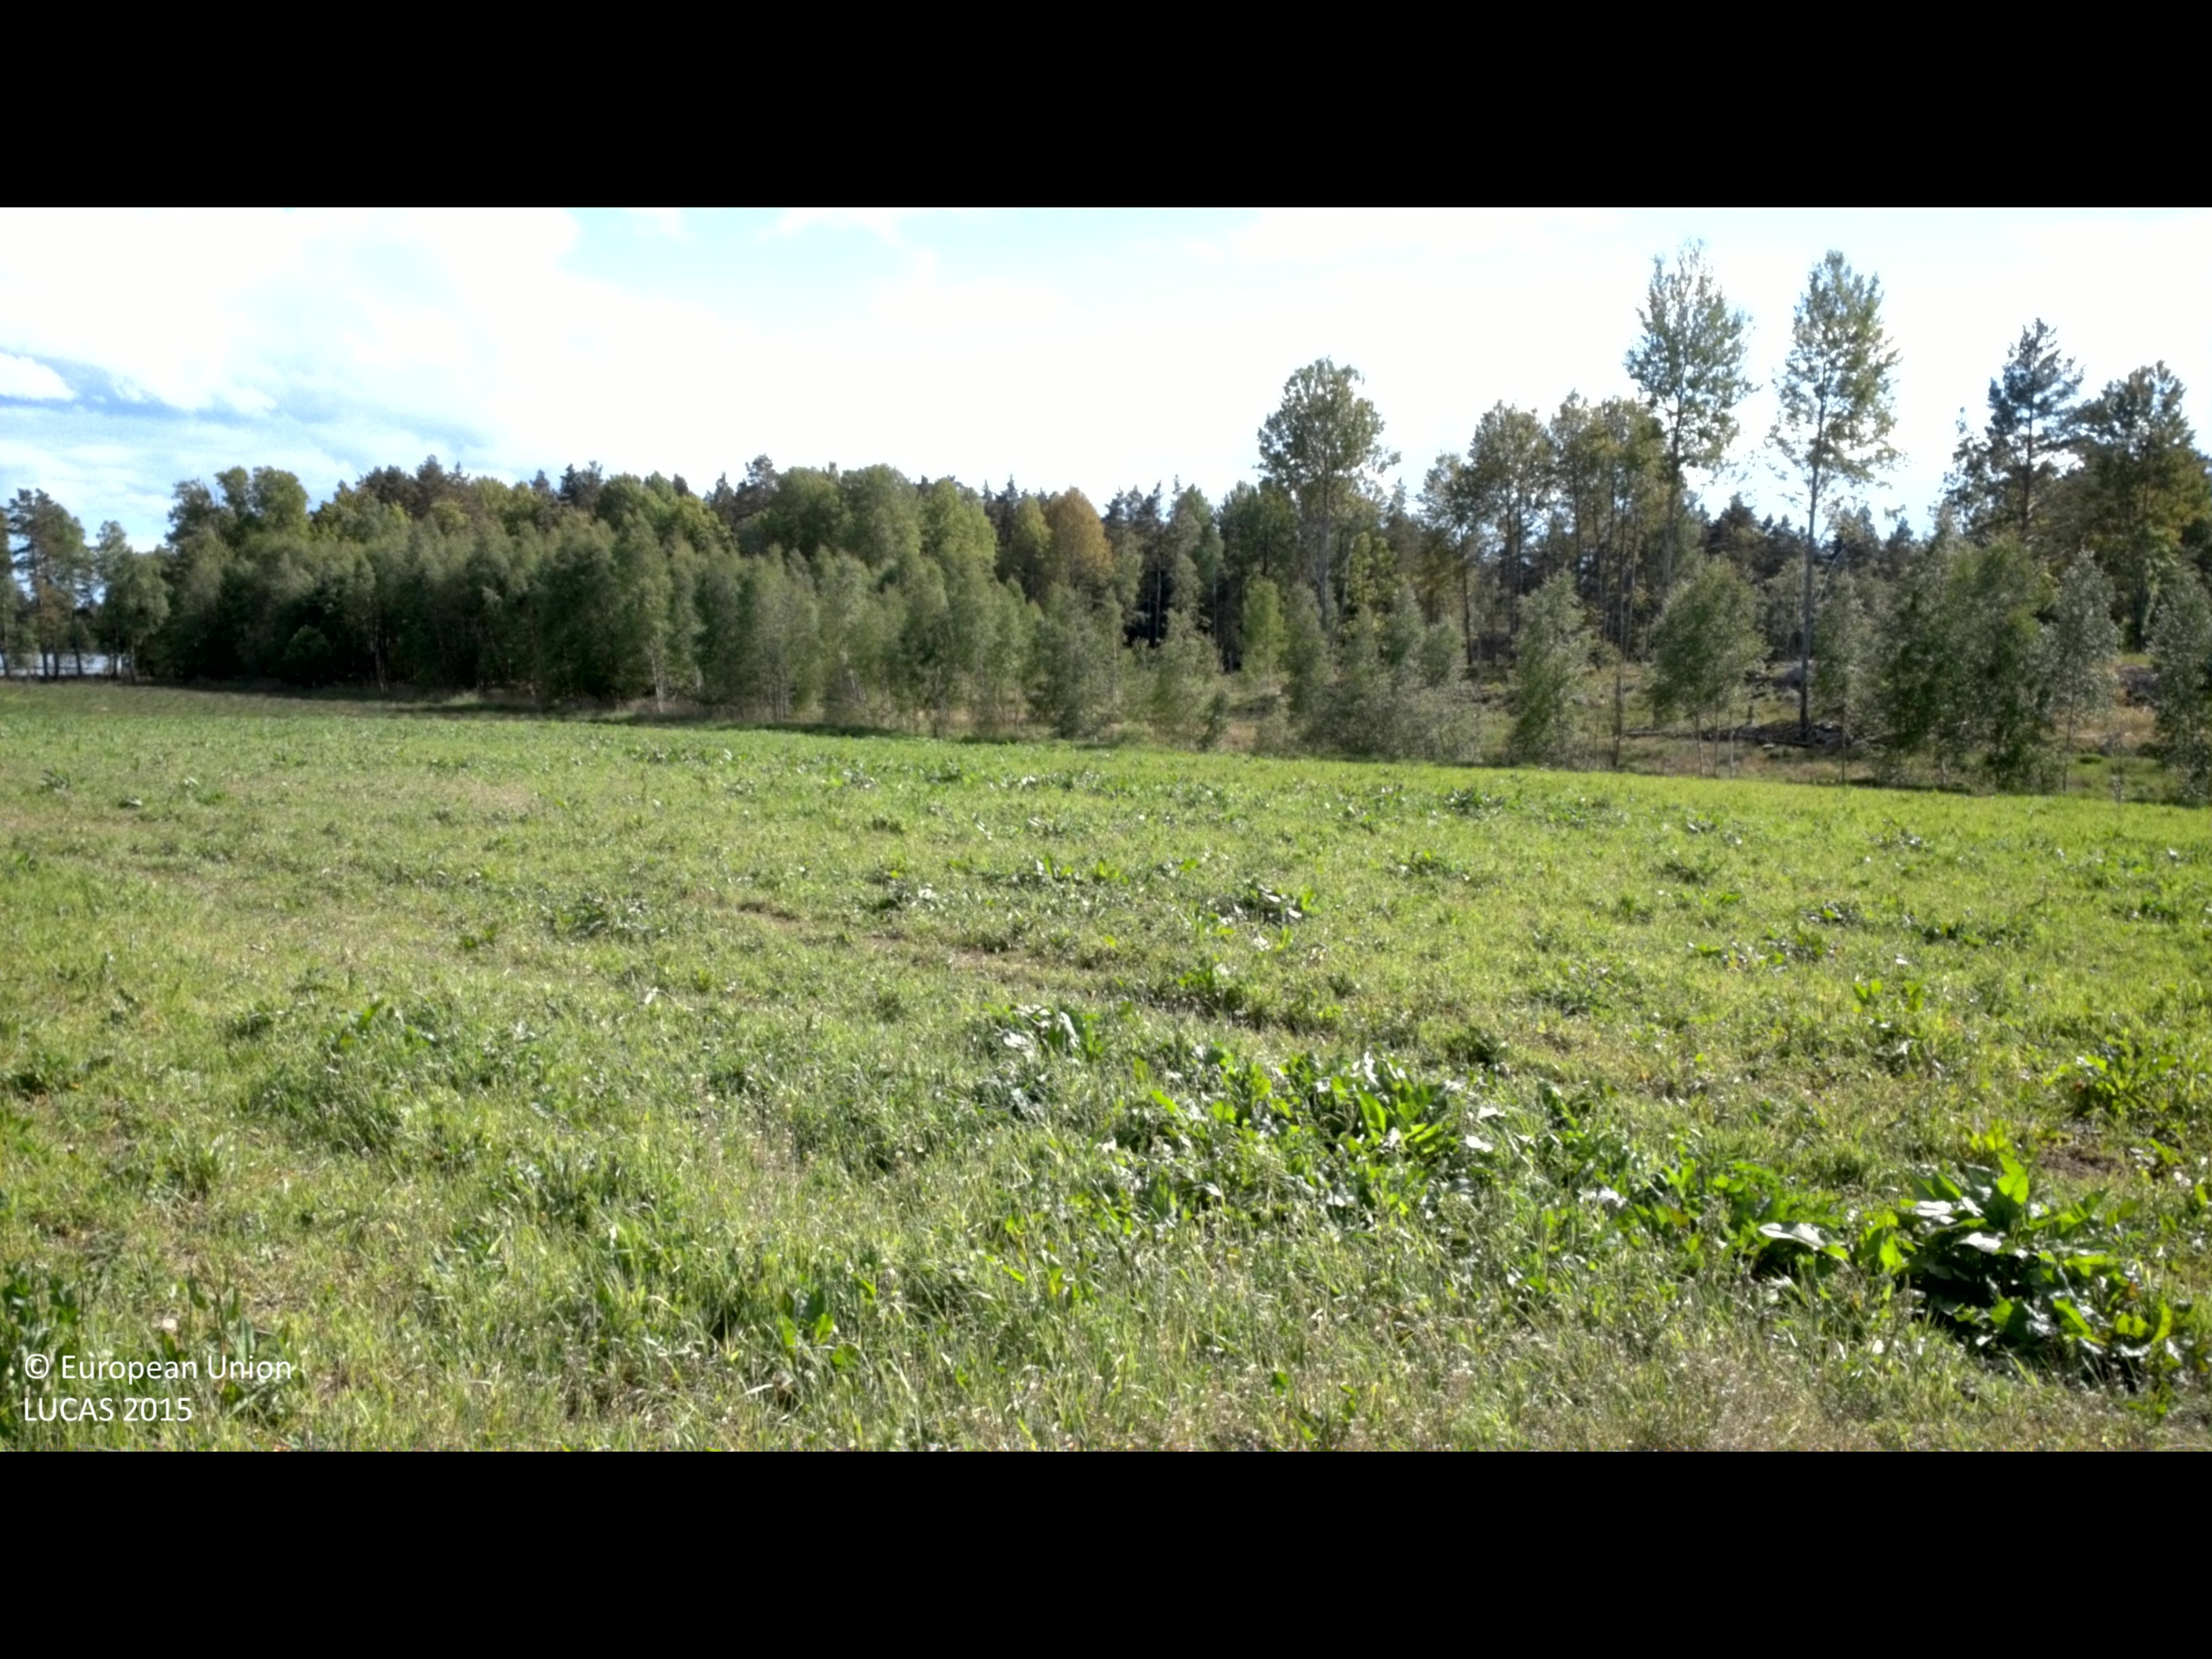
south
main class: Grassland
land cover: Grassland with sparse tree/shrub cover
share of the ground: > 75 %
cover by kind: herbaceous plants 90 %, broadleaved forest trees 5 %, shrubs 5 %
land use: Agriculture (excluding fallow land and kitchen gardens)
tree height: > 5 m
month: May
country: SE
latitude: 57.5389
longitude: 16.4973
